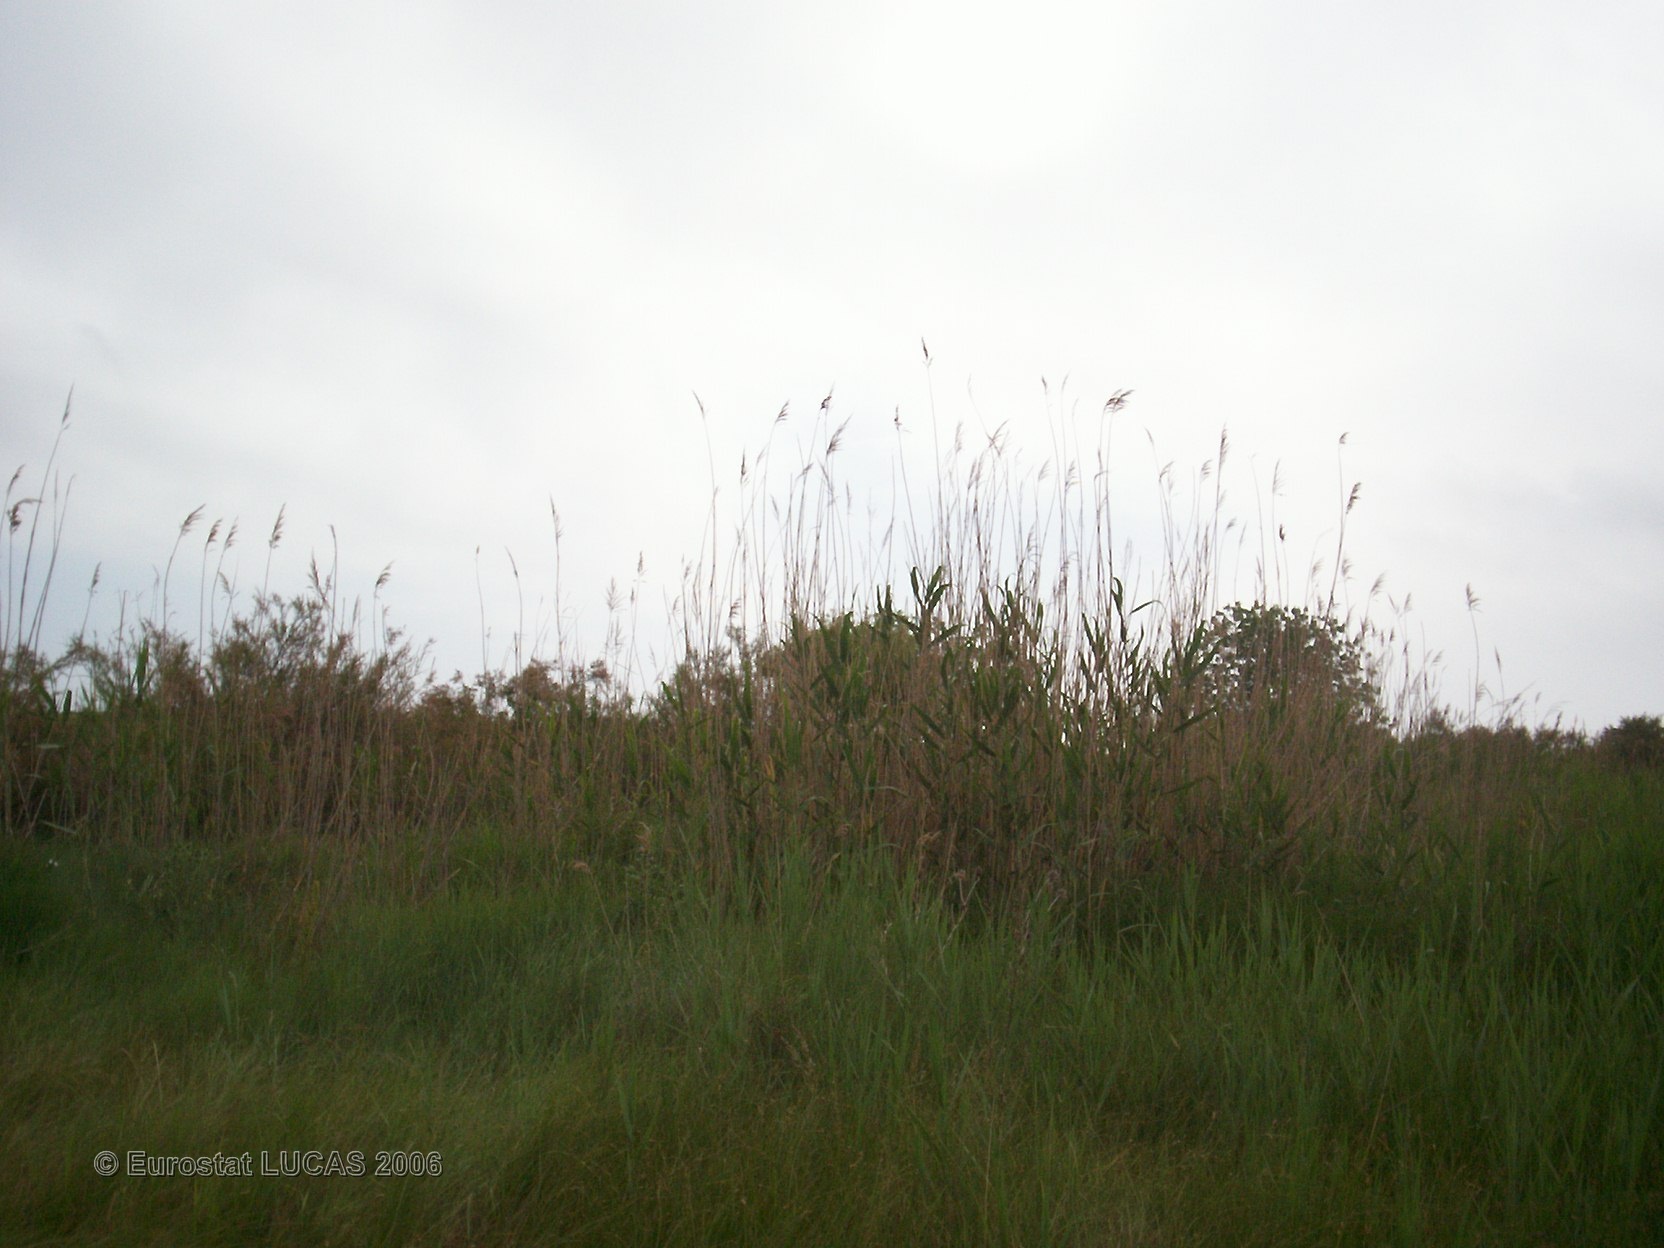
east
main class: Grassland
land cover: Grassland without tree/shrub cover
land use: Unused
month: May
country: FR
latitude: 43.3330
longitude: 3.5101
